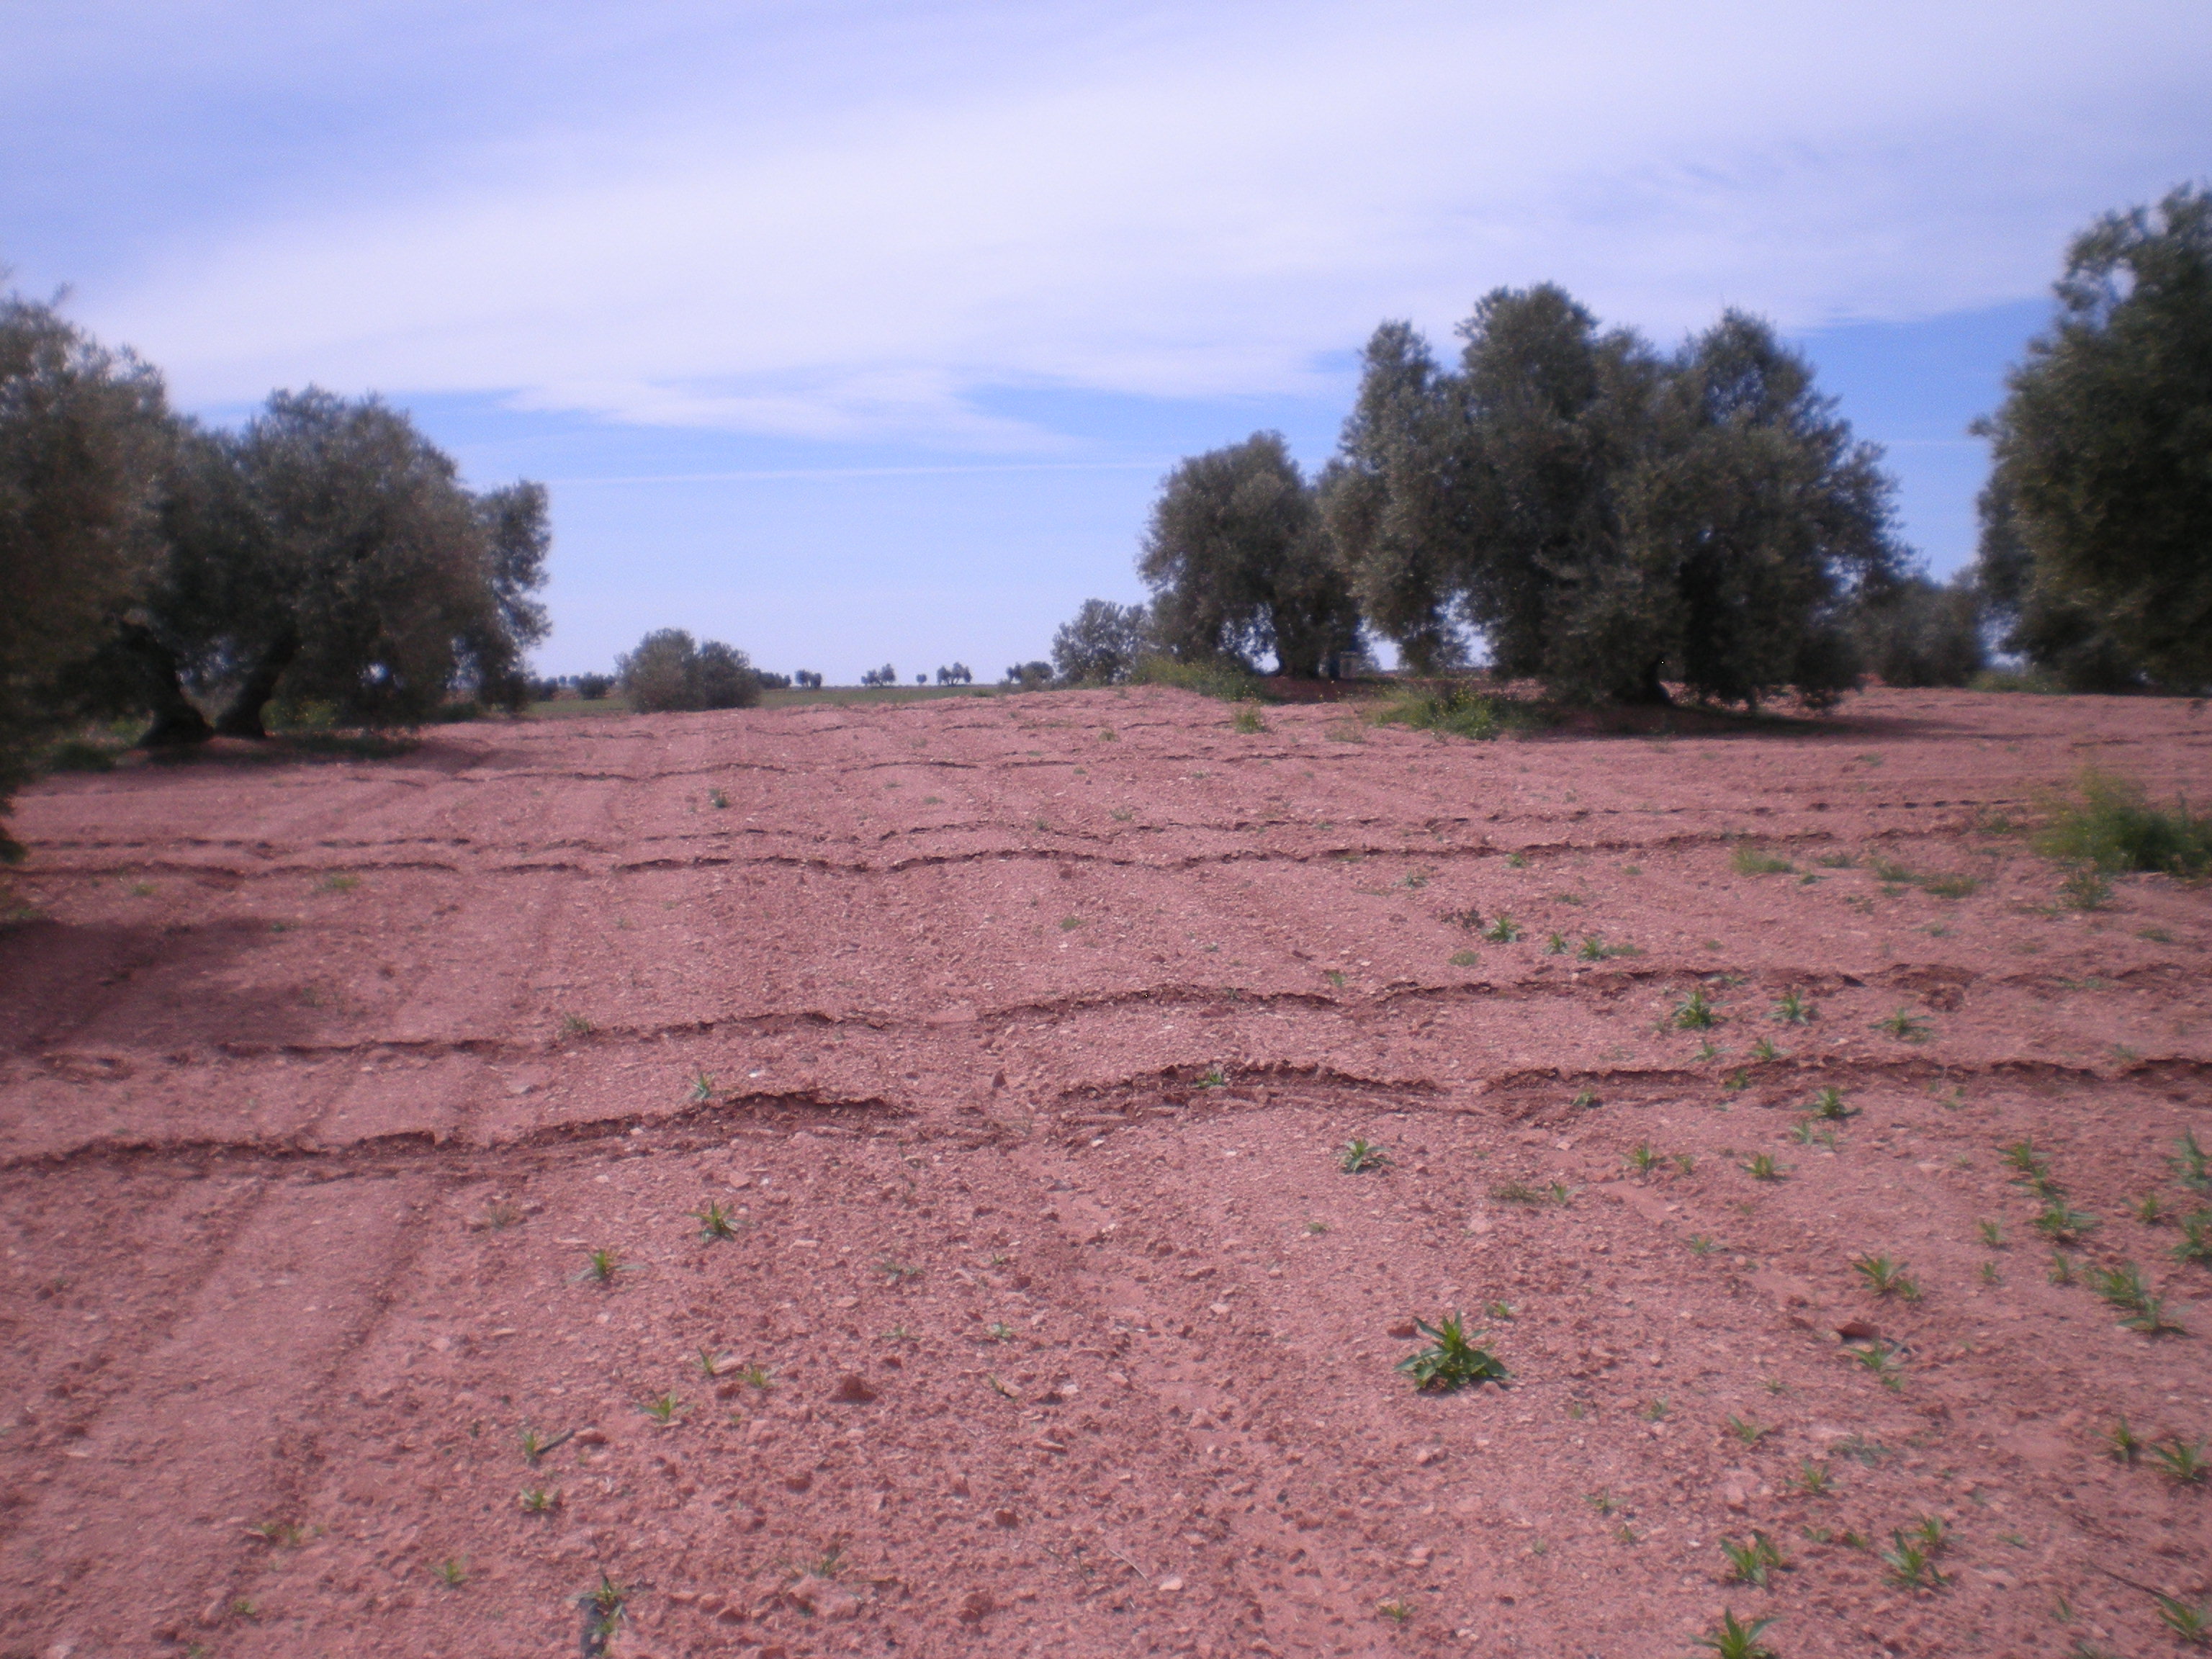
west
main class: Cropland
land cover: Olive groves
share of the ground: 10 - 25 %
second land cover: Other bare soil
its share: > 75 %
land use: Agriculture (excluding fallow land and kitchen gardens)
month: April
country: ES
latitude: 38.8933
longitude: -3.2122
